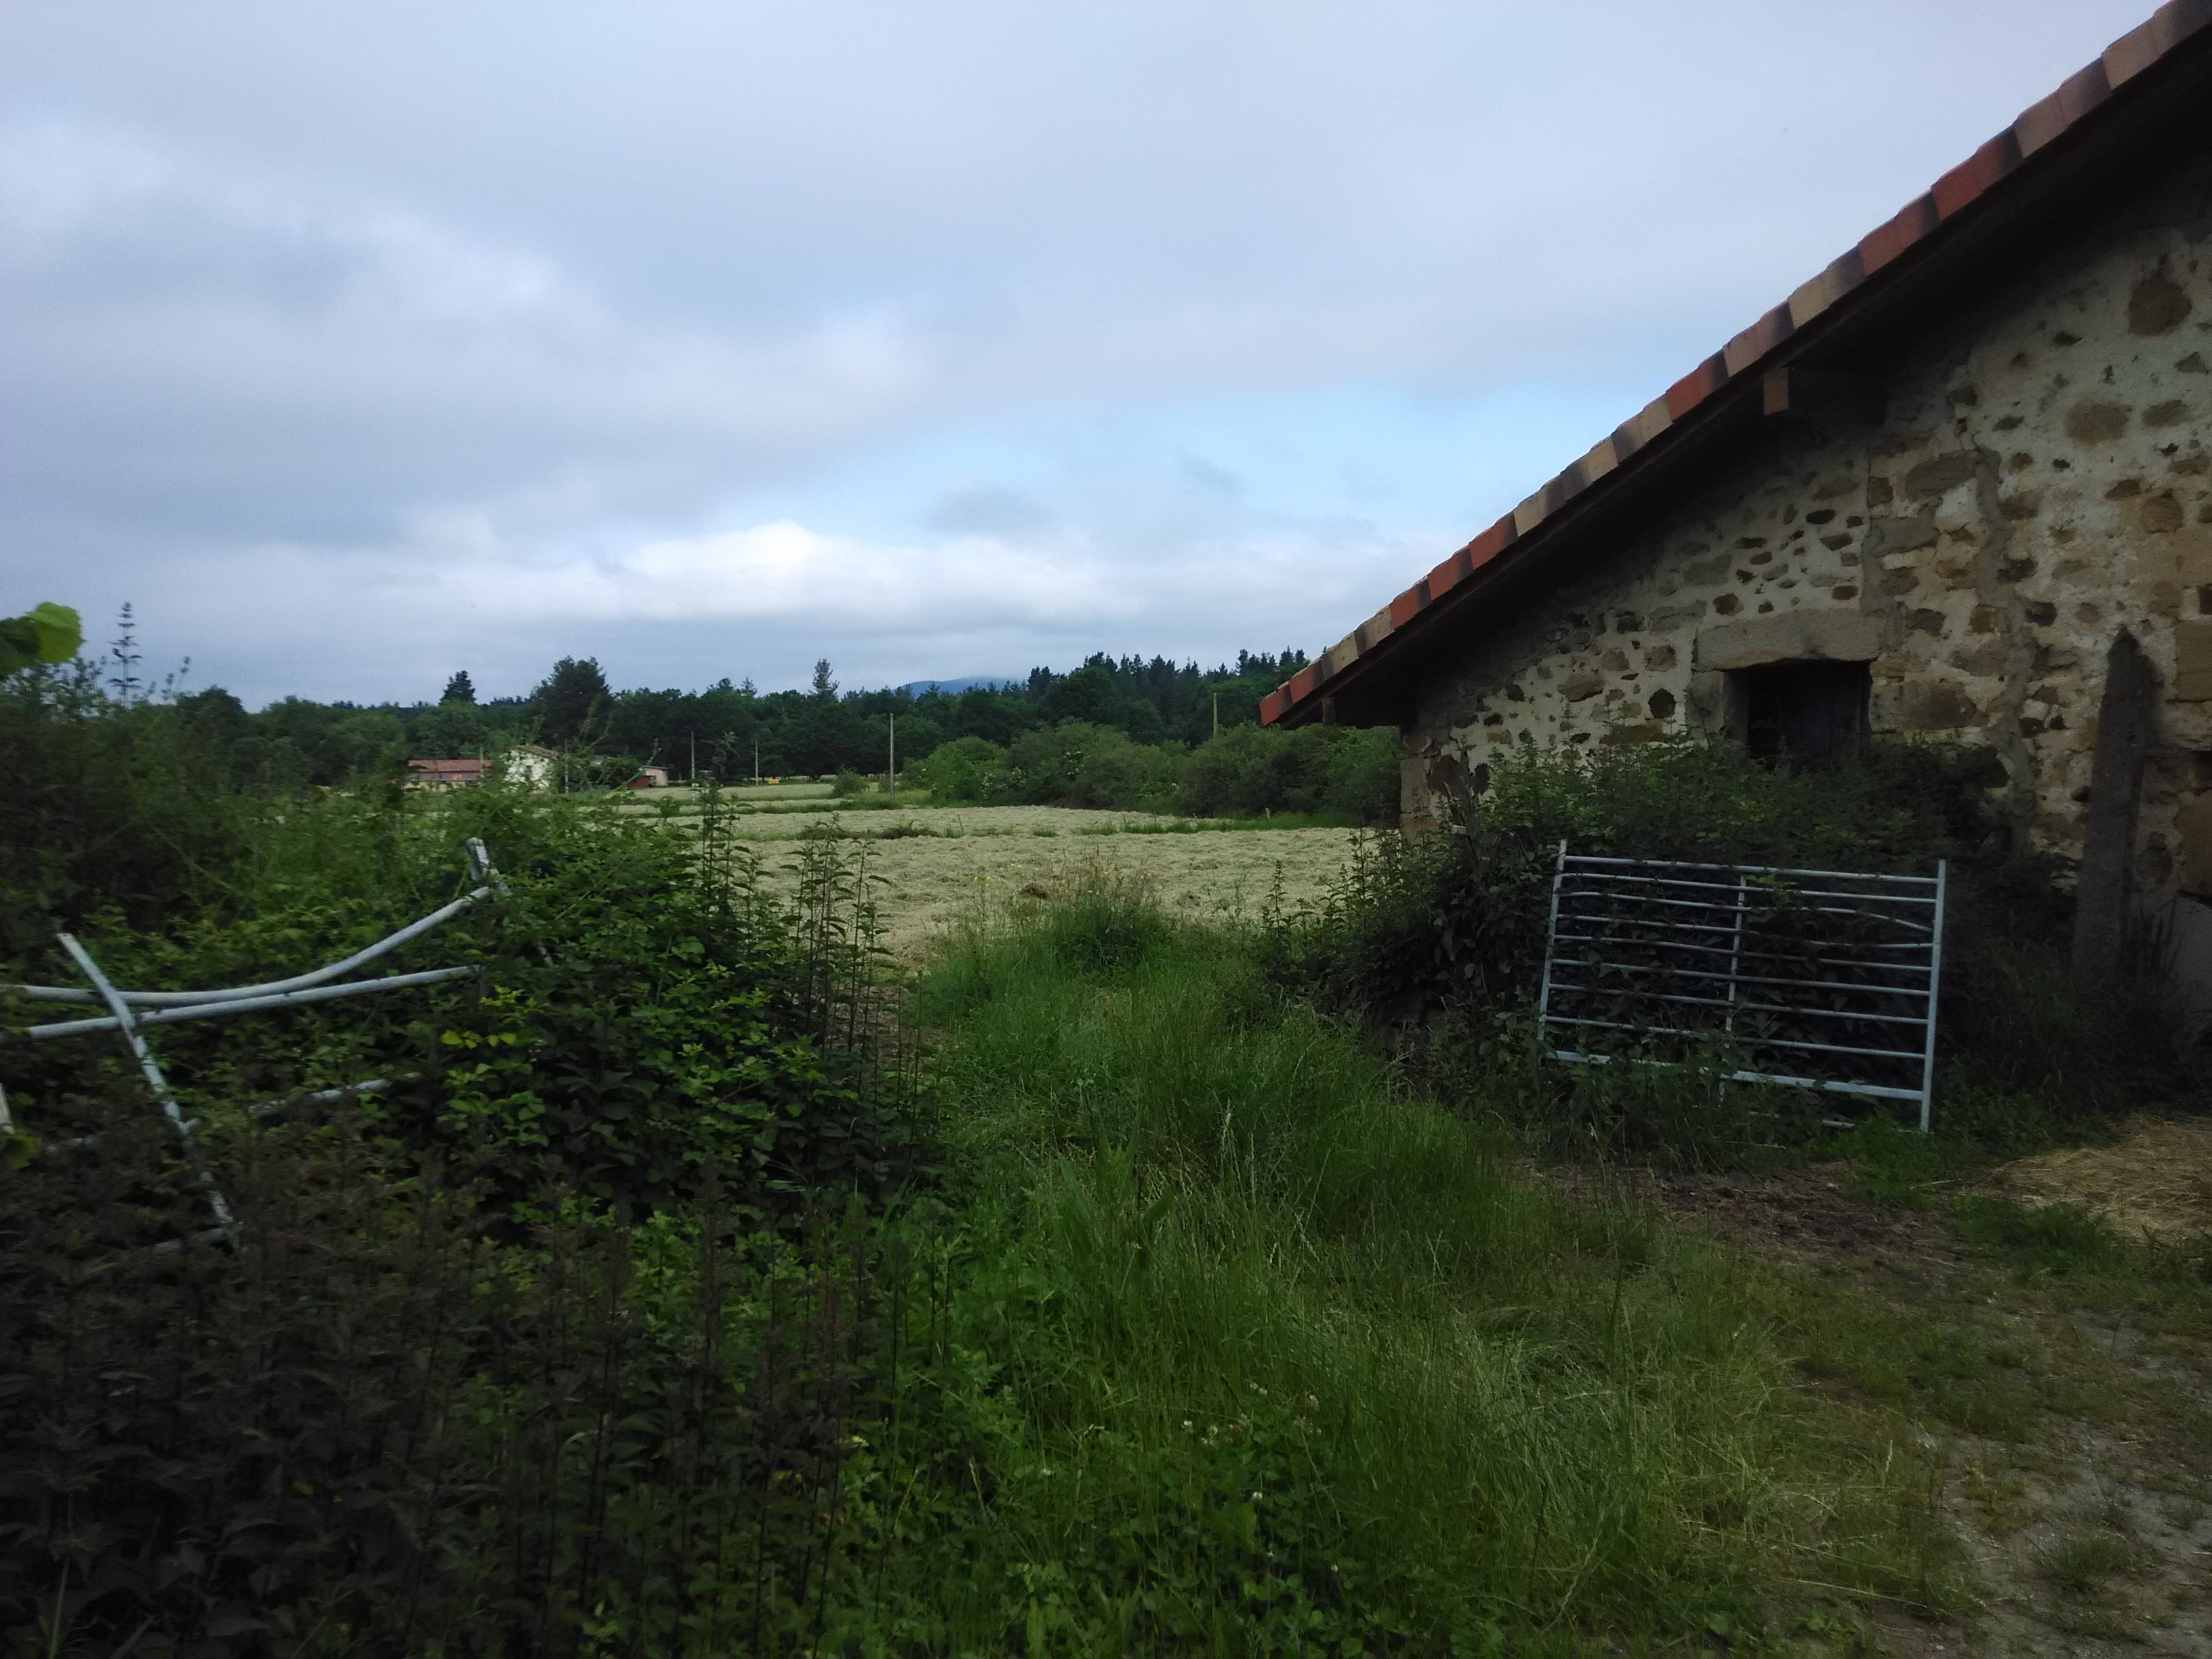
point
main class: Woodland
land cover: Broadleaved woodland
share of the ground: 25 - 50 %
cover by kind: herbaceous plants 60 %, broadleaved forest trees 40 %
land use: Semi-natural and natural areas not in use
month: June
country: ES
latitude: 42.9216
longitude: -2.4597
